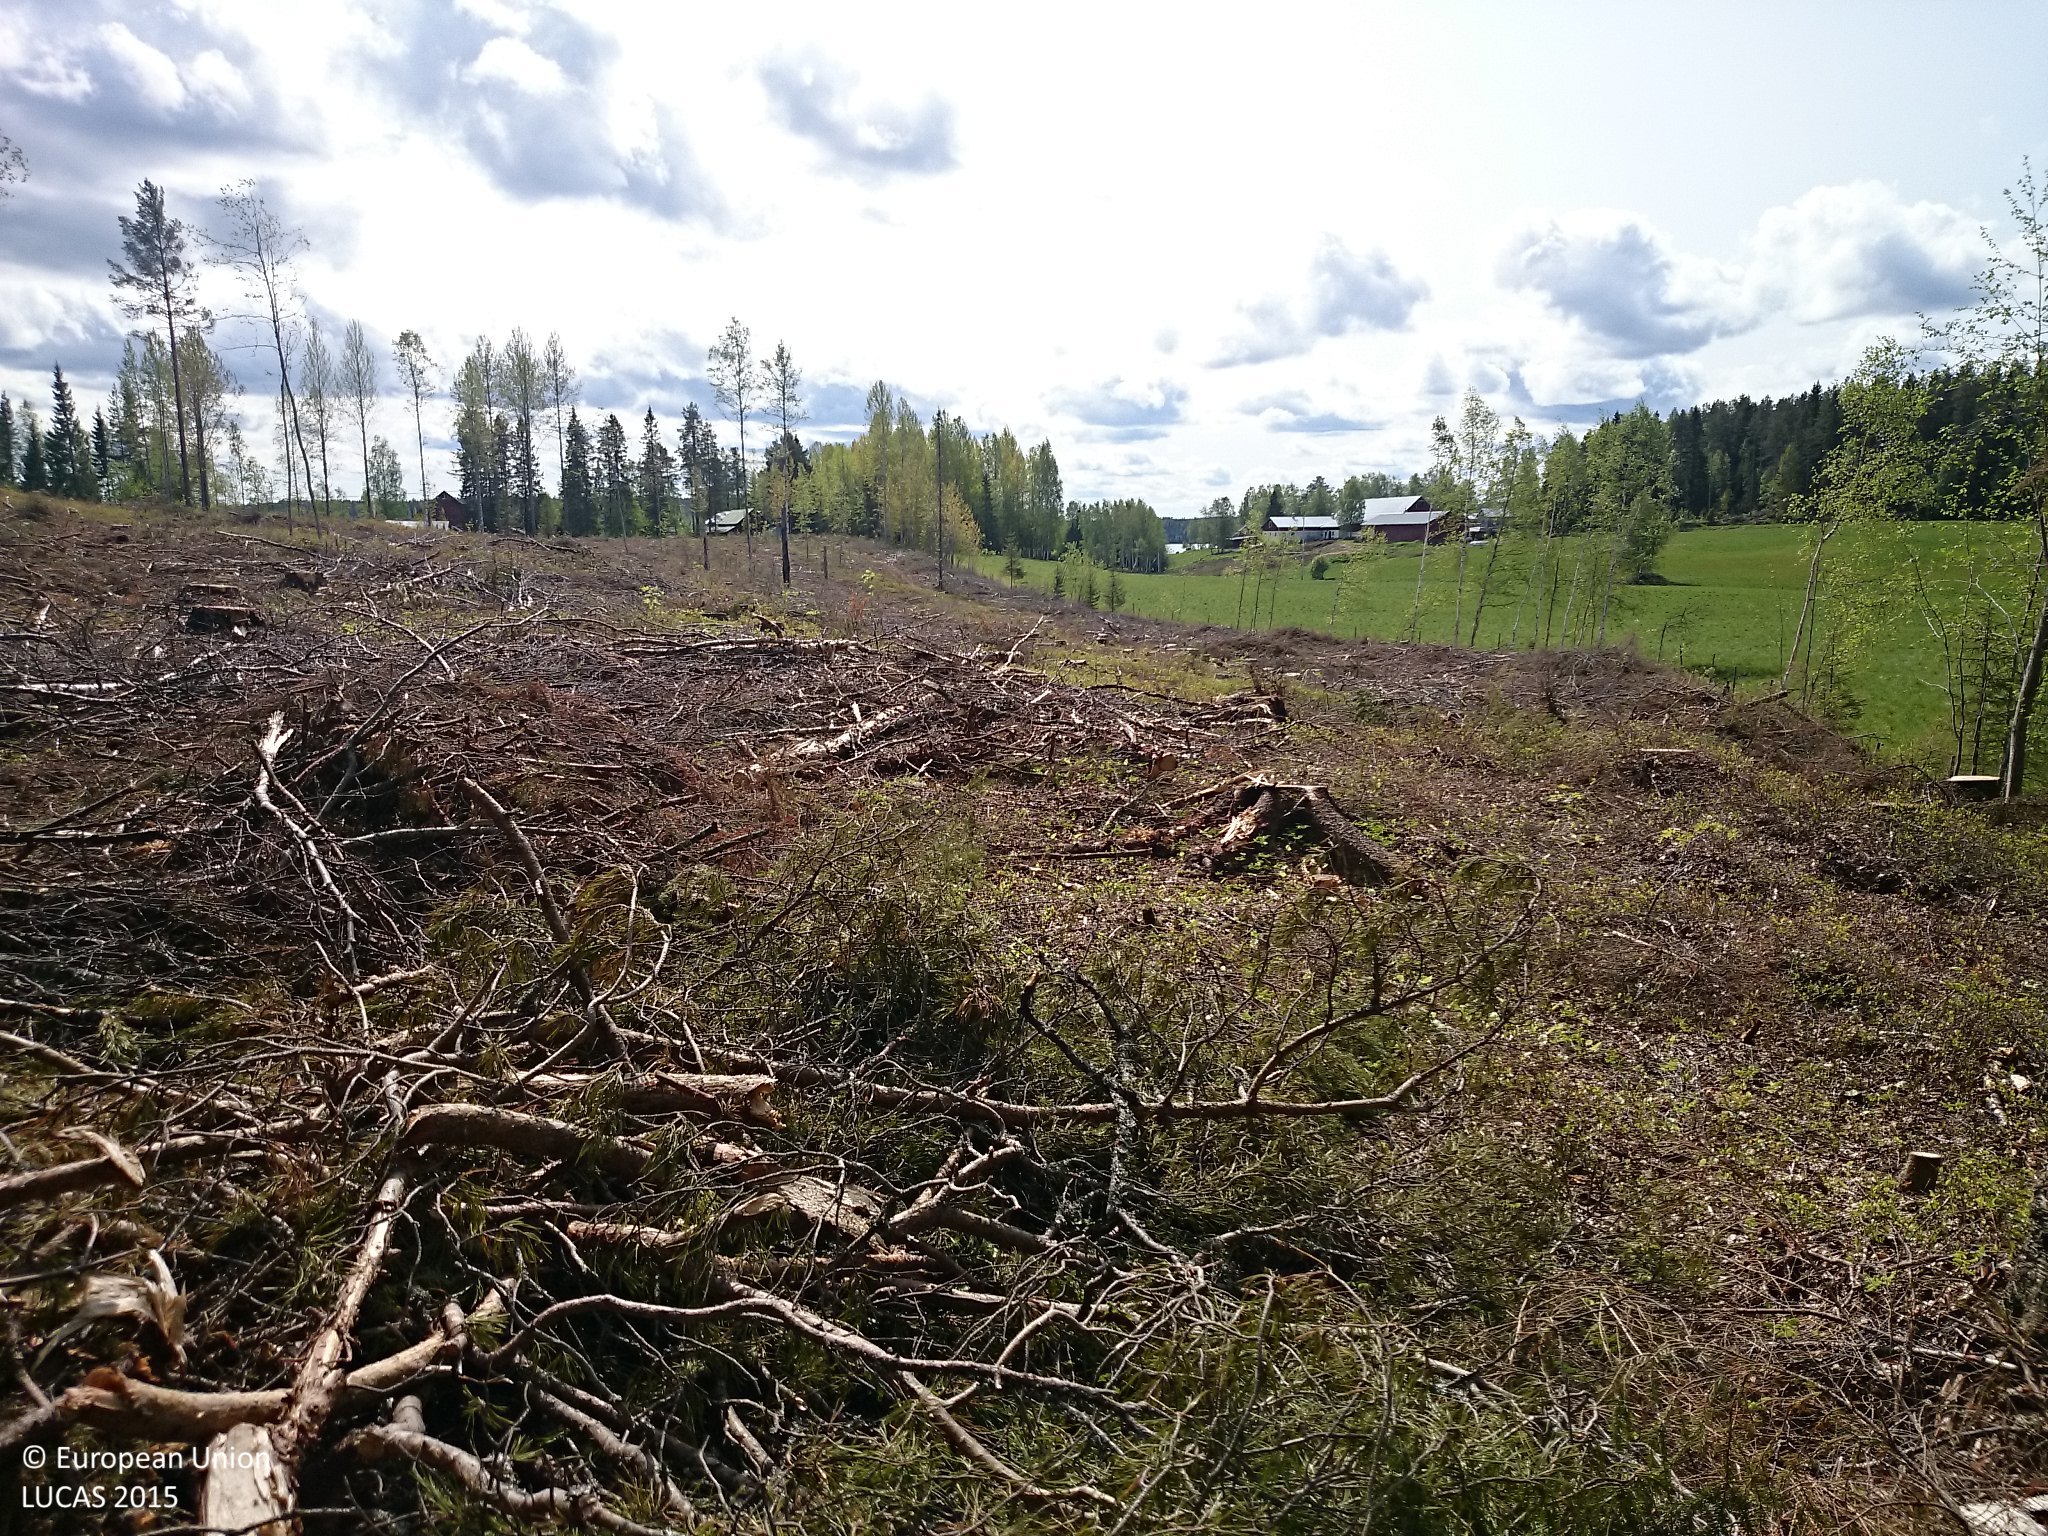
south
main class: Shrubland
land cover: Shrubland with sparse tree cover
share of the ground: 50 - 75 %
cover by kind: shrubs 45 %, herbaceous plants 10 %, broadleaved forest trees 5 %, lichens and mosses 5 %
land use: Forestry
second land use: Amenities, museums, leisure
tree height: > 5 m
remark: Clear cut
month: June
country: SE
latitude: 64.0177
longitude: 20.1474
